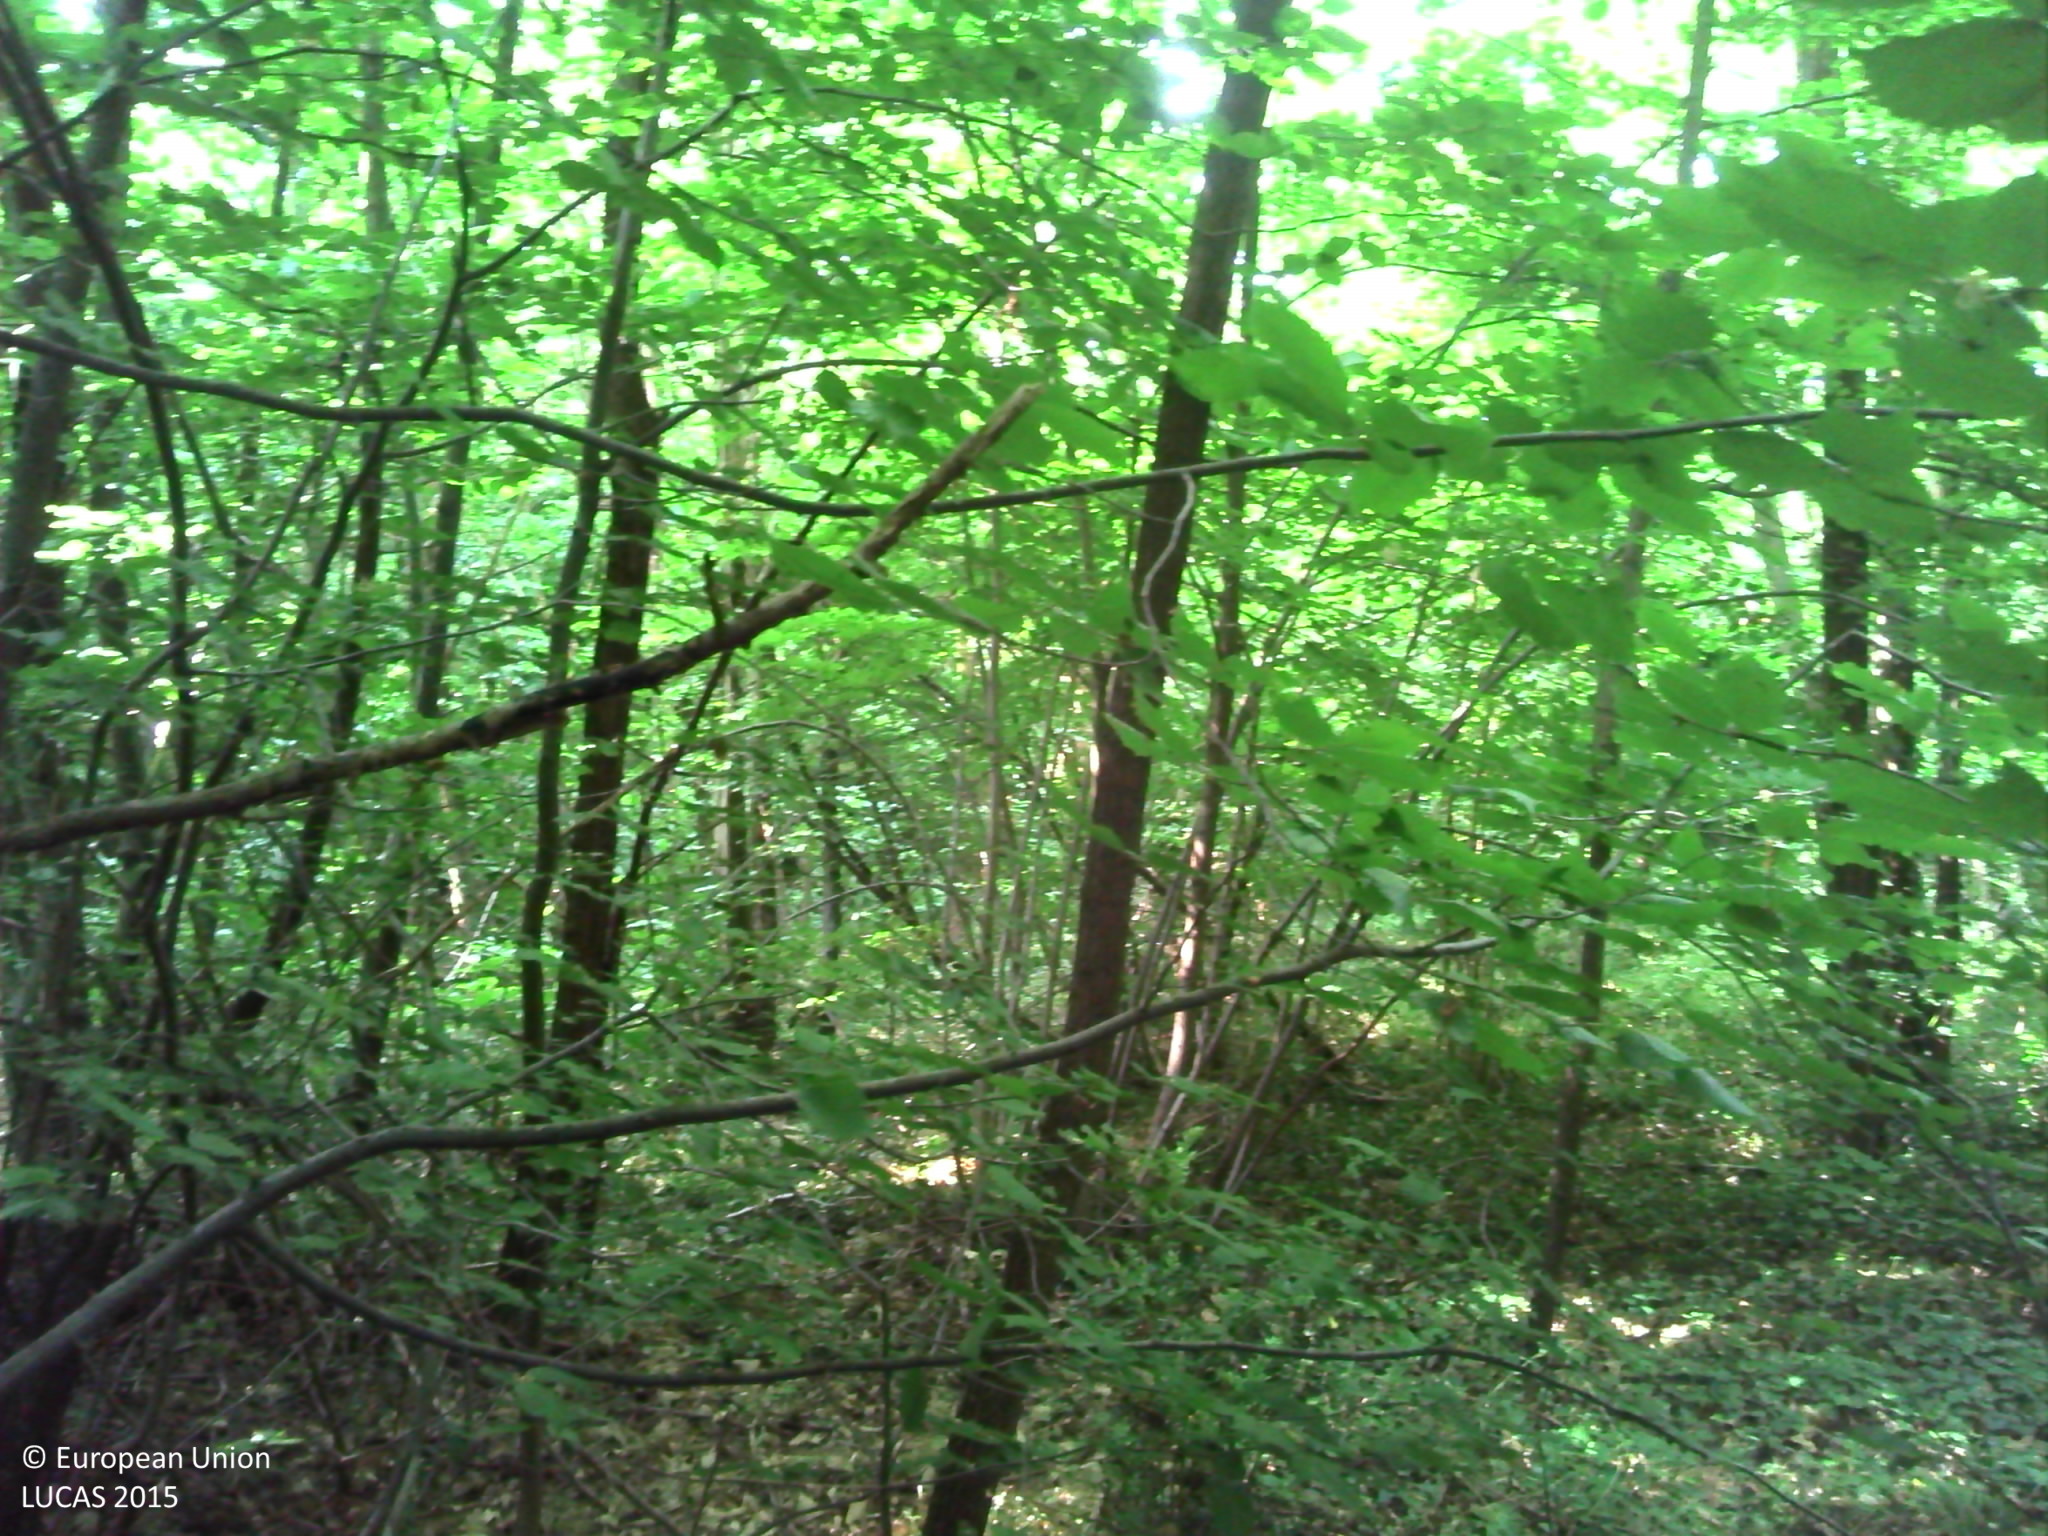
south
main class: Woodland
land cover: Broadleaved woodland
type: acidophilous oak and oak-birch forest
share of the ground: > 75 %
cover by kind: broadleaved forest trees 85 %, herbaceous plants 15 %
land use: Forestry
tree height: > 5 m
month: June
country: FR
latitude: 46.1004
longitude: 4.8414
